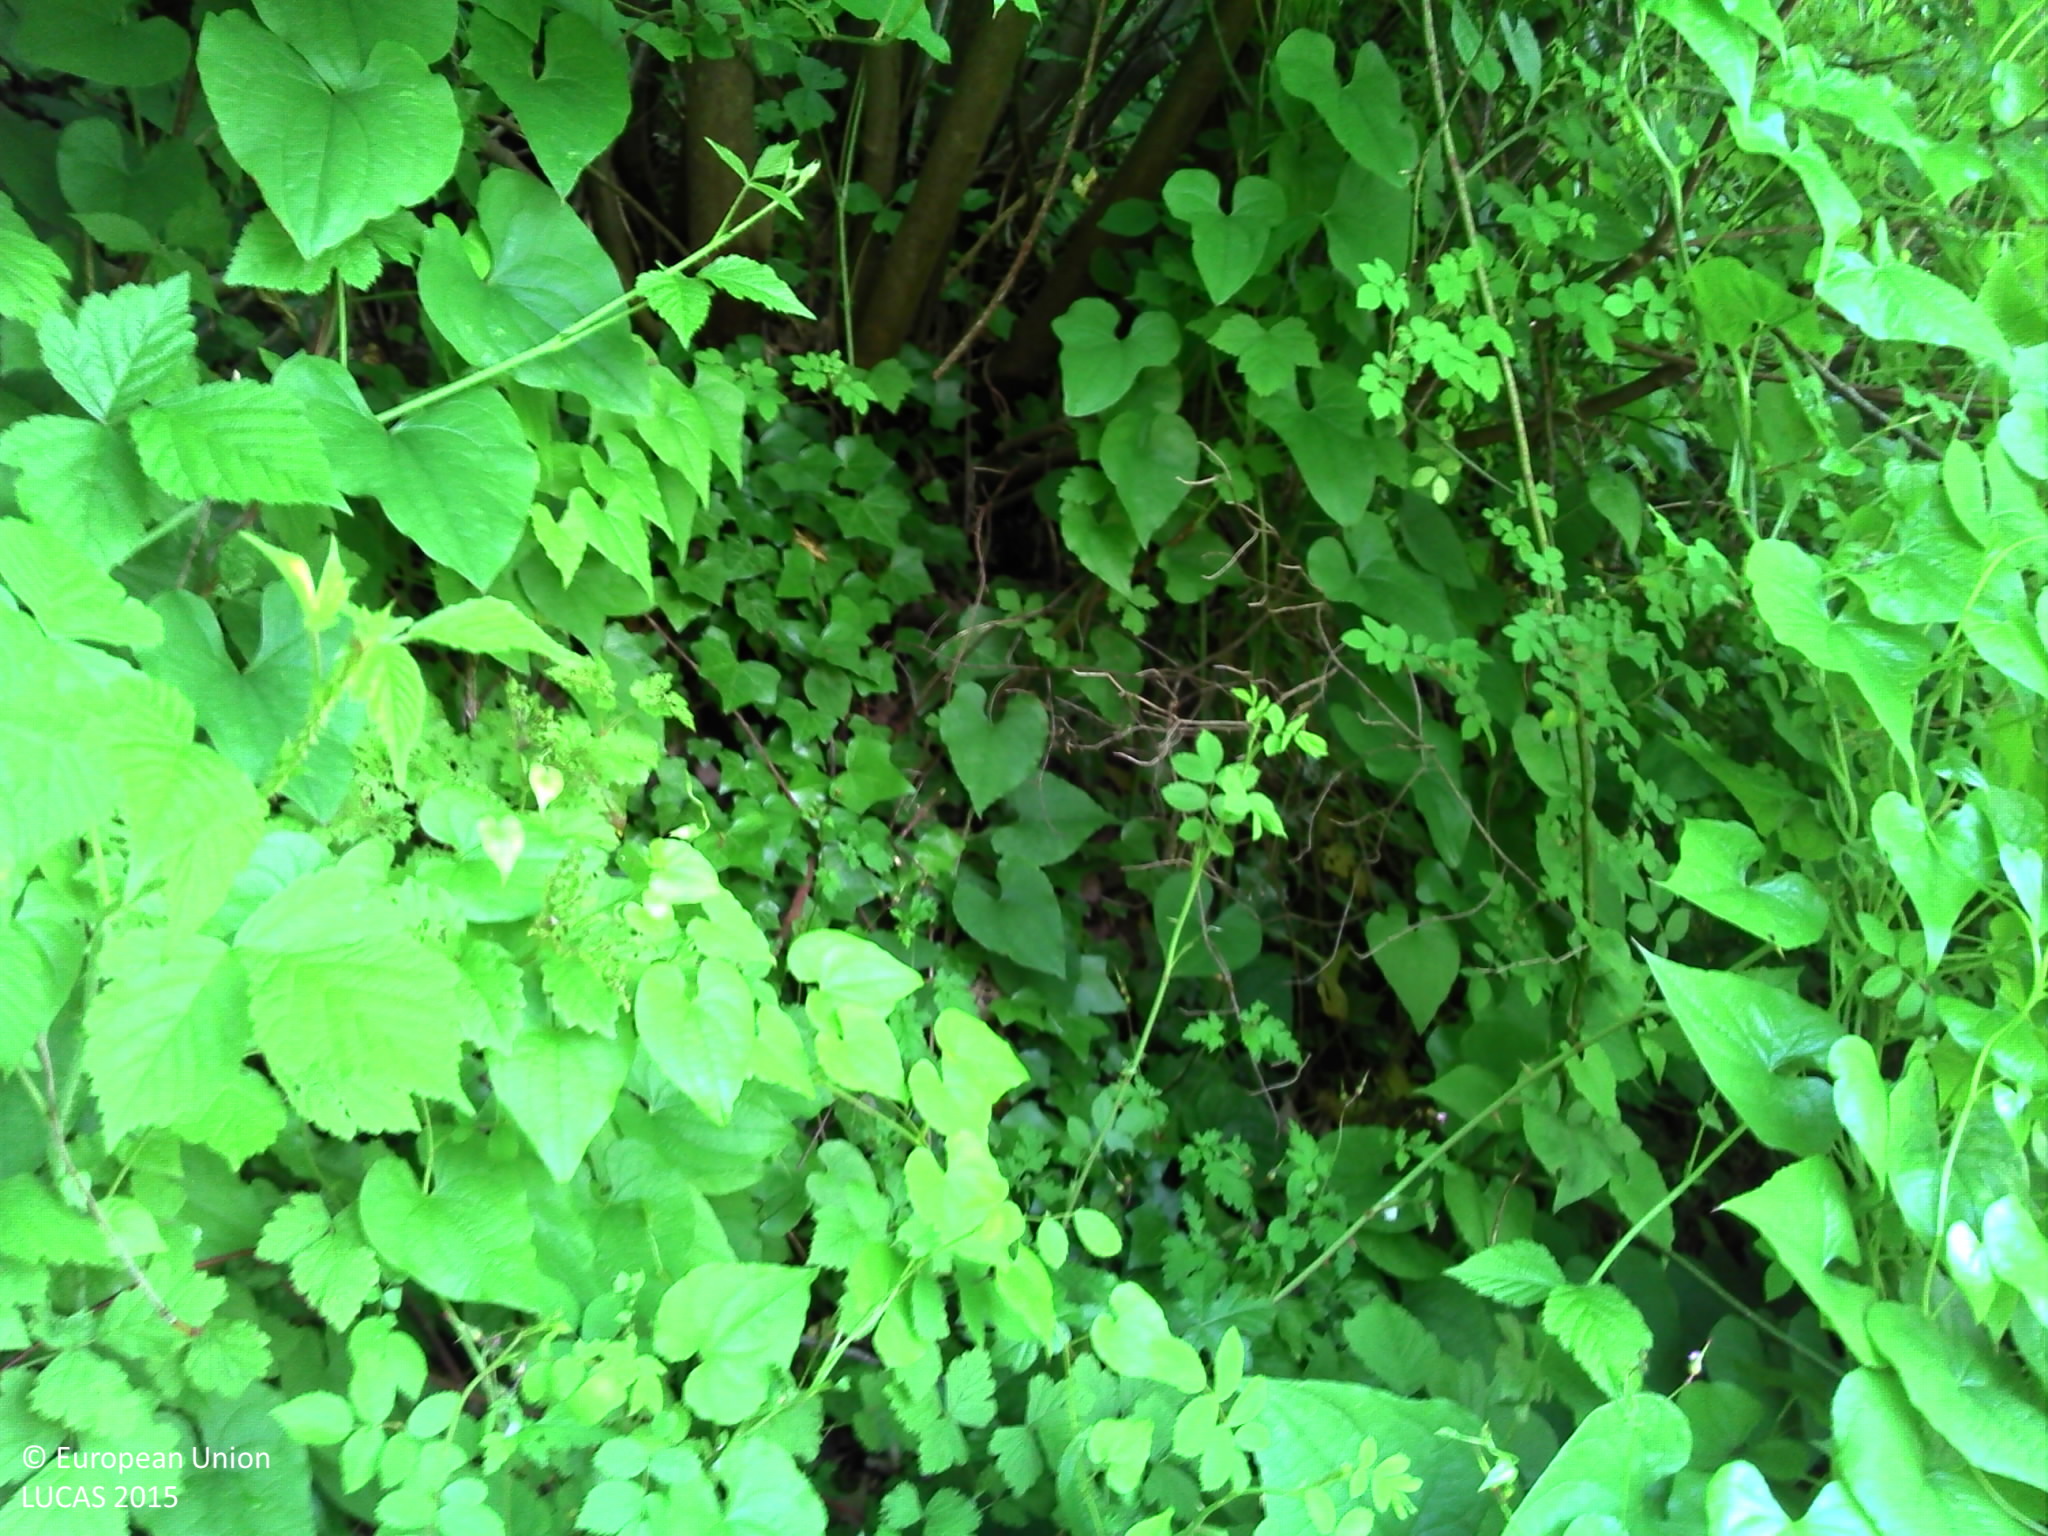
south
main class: Woodland
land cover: Broadleaved woodland
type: mesophytic deciduous forest
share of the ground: > 75 %
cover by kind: broadleaved forest trees 75 %, herbaceous plants 15 %, shrubs 10 %
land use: Forestry
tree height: > 5 m
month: June
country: FR
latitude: 50.6154
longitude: 2.1129
